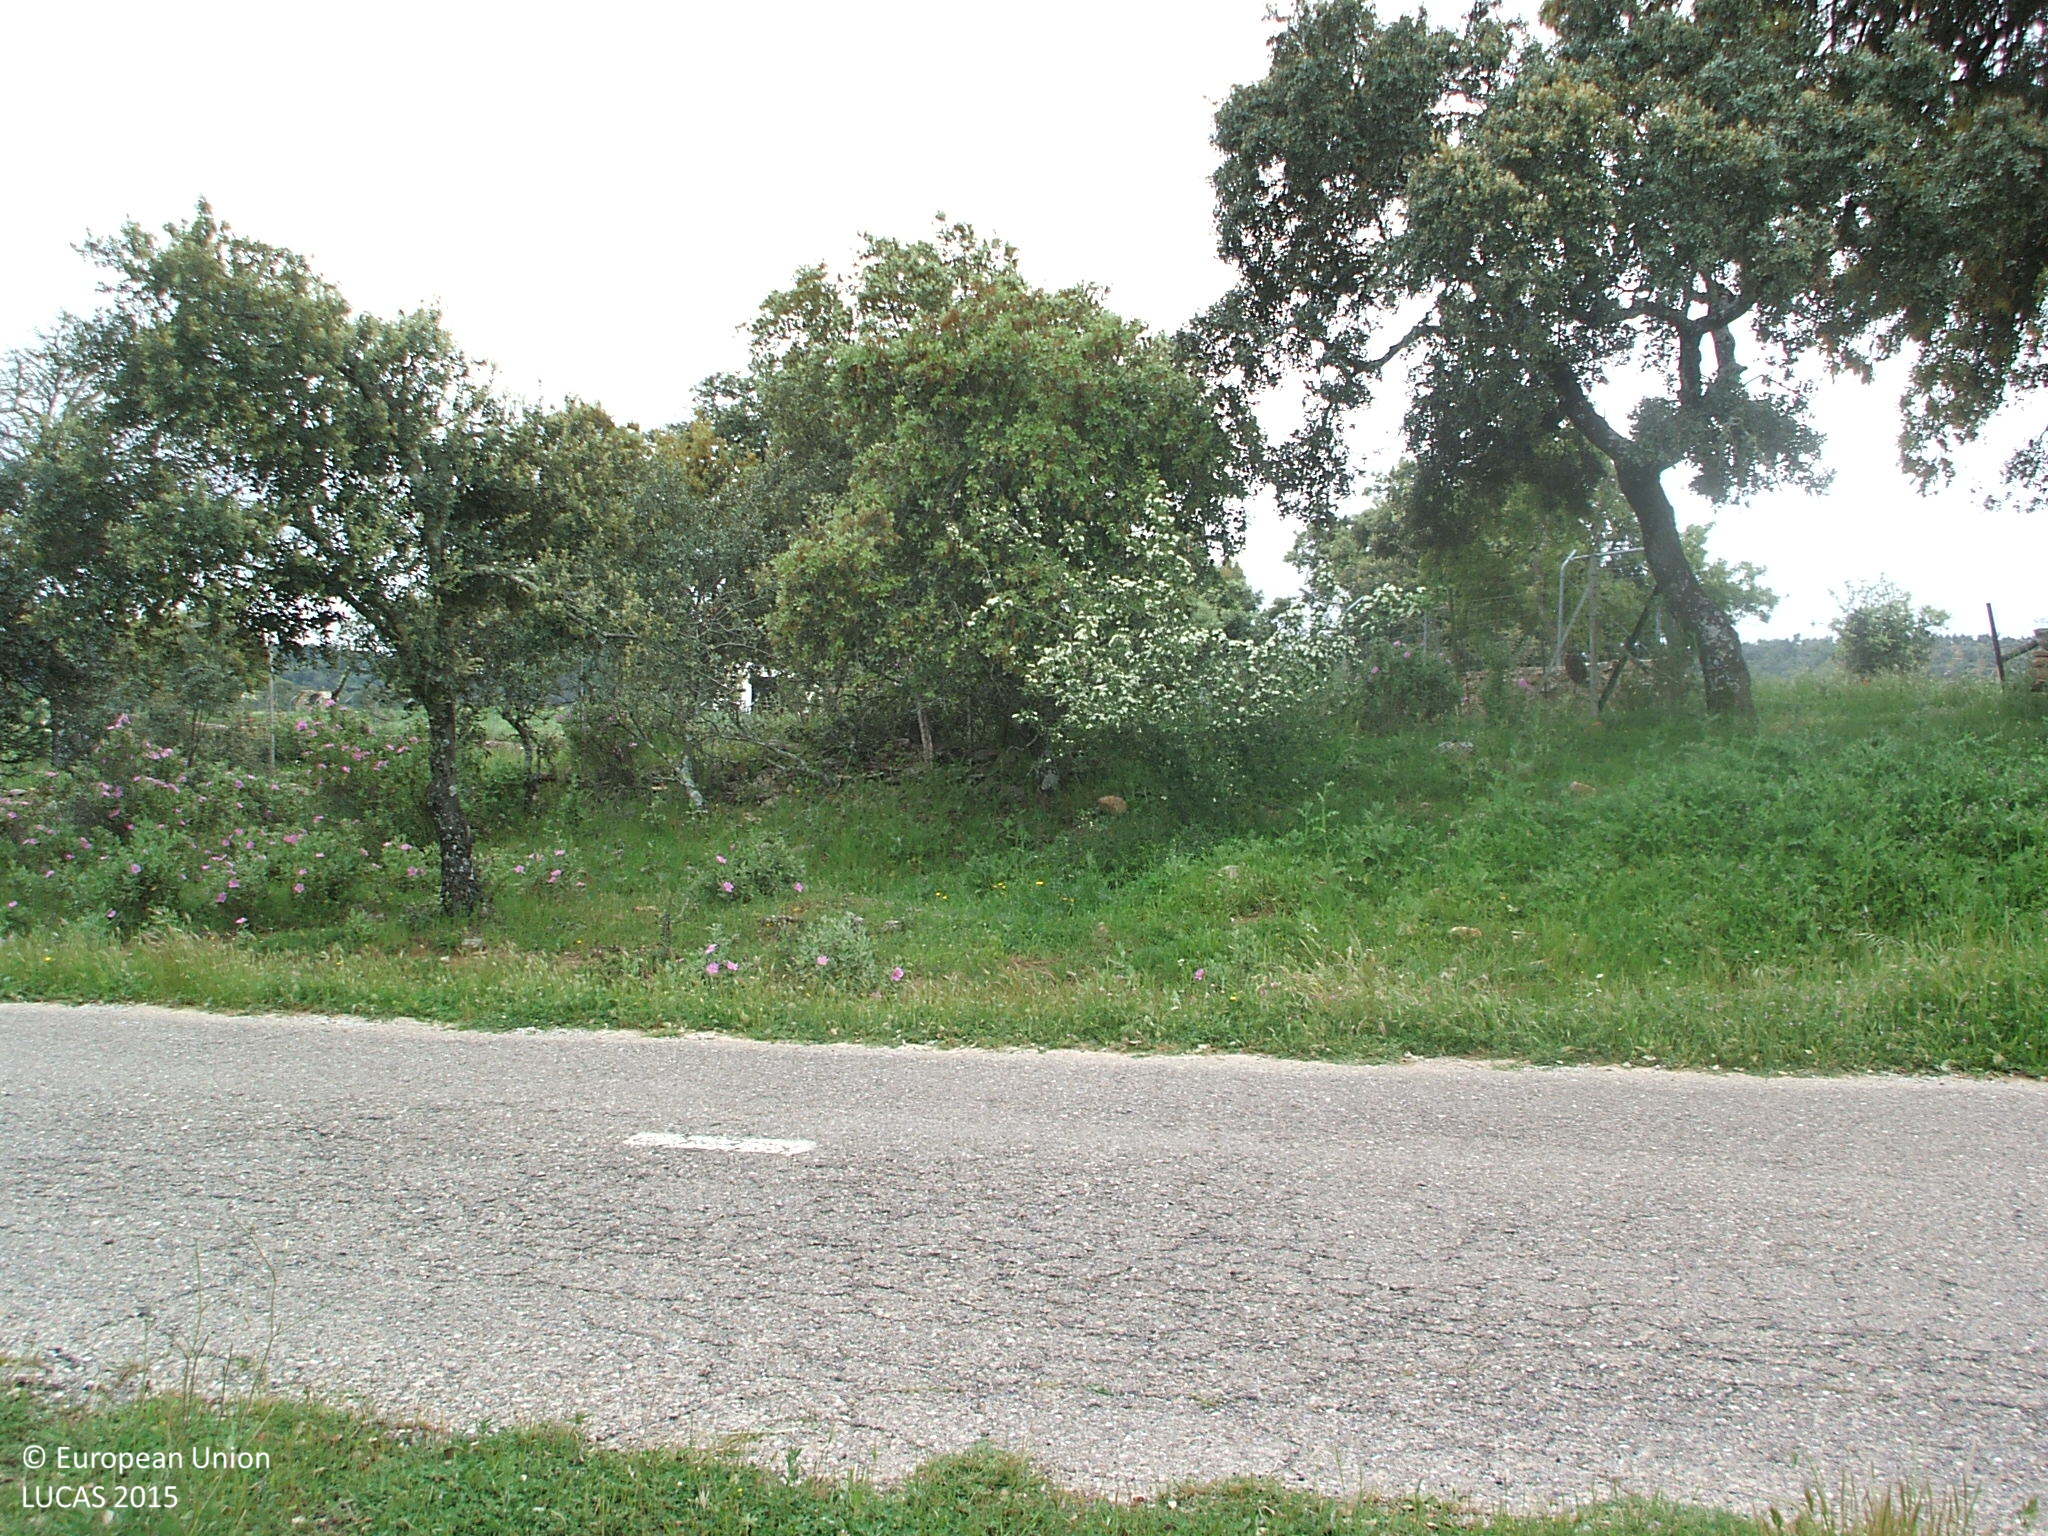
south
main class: Woodland
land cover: Broadleaved woodland
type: broadleaved evergreen forest
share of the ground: 10 - 25 %
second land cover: Grassland without tree/shrub cover
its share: > 75 %
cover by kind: herbaceous plants 80 %, broadleaved forest trees 20 %
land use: Forestry
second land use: Agriculture (excluding fallow land and kitchen gardens)
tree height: > 5 m
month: April
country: ES
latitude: 38.0416
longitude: -5.6750
